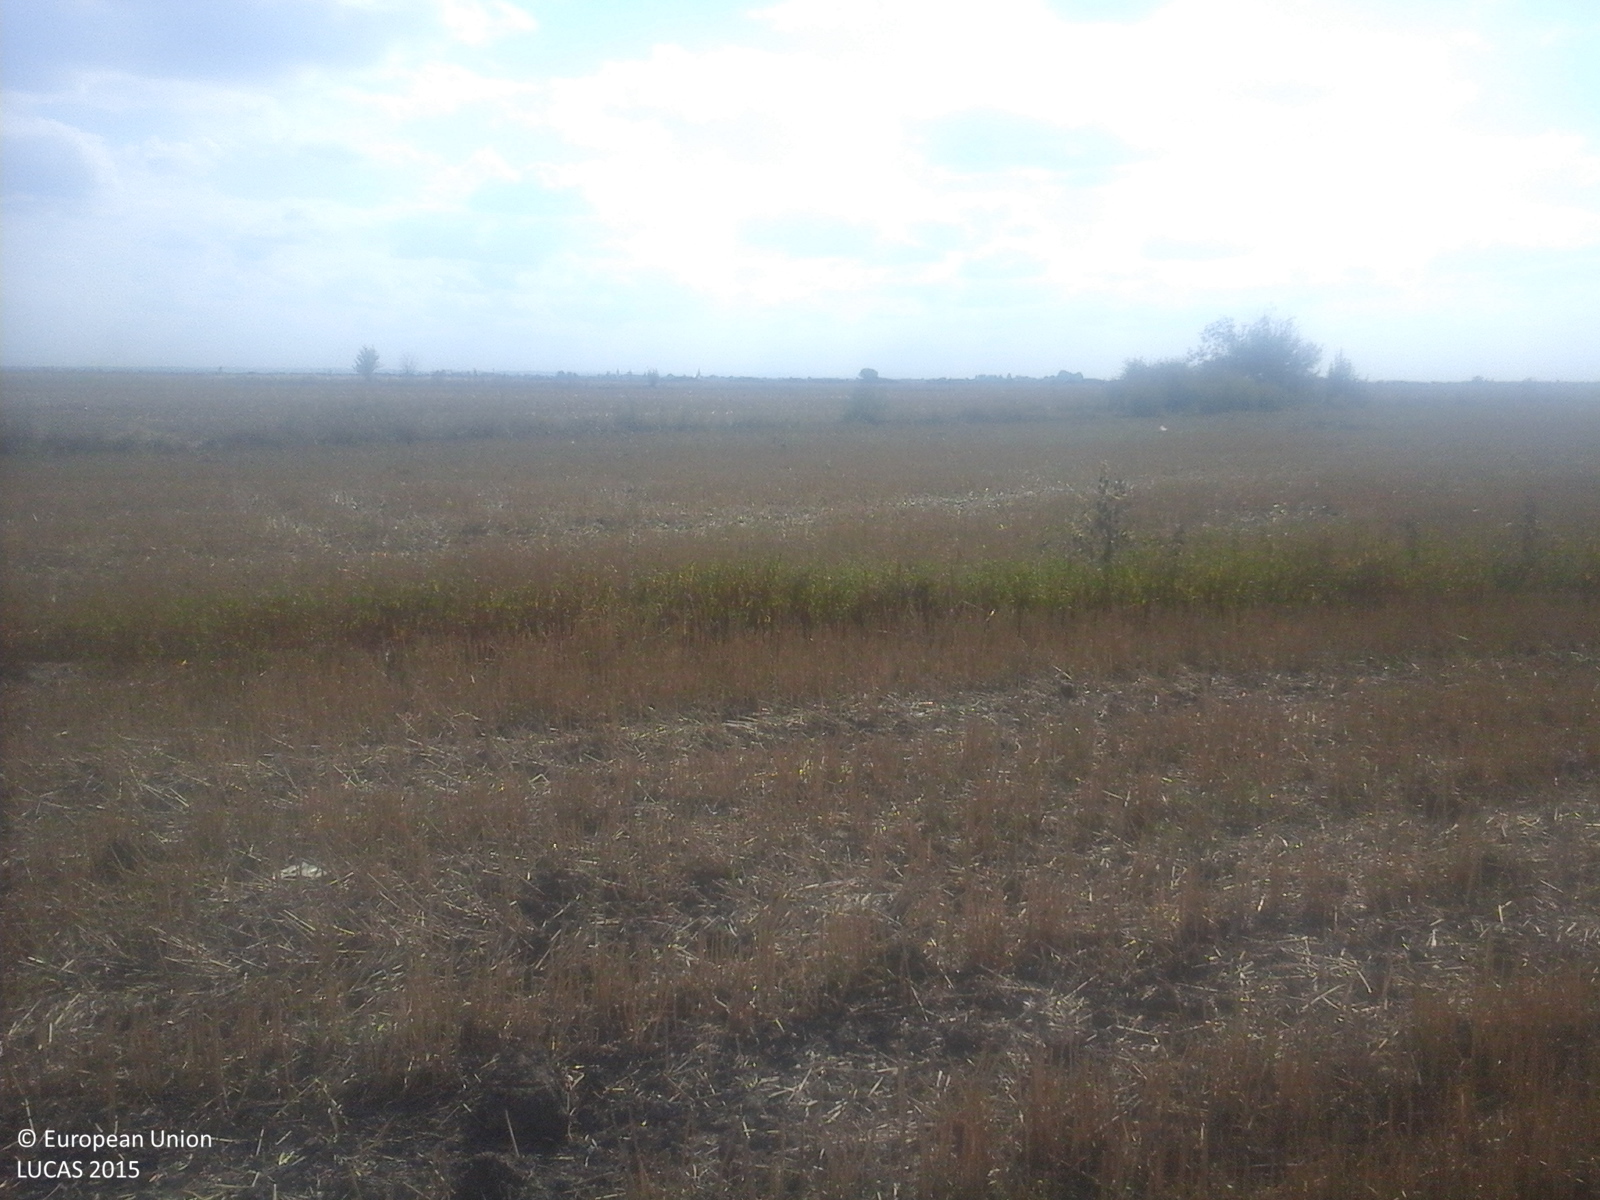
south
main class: Cropland
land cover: Common wheat
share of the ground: < 10 %
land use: Agriculture (excluding fallow land and kitchen gardens)
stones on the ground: < 10 %
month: September
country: RO
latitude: 47.6469
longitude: 22.7213
